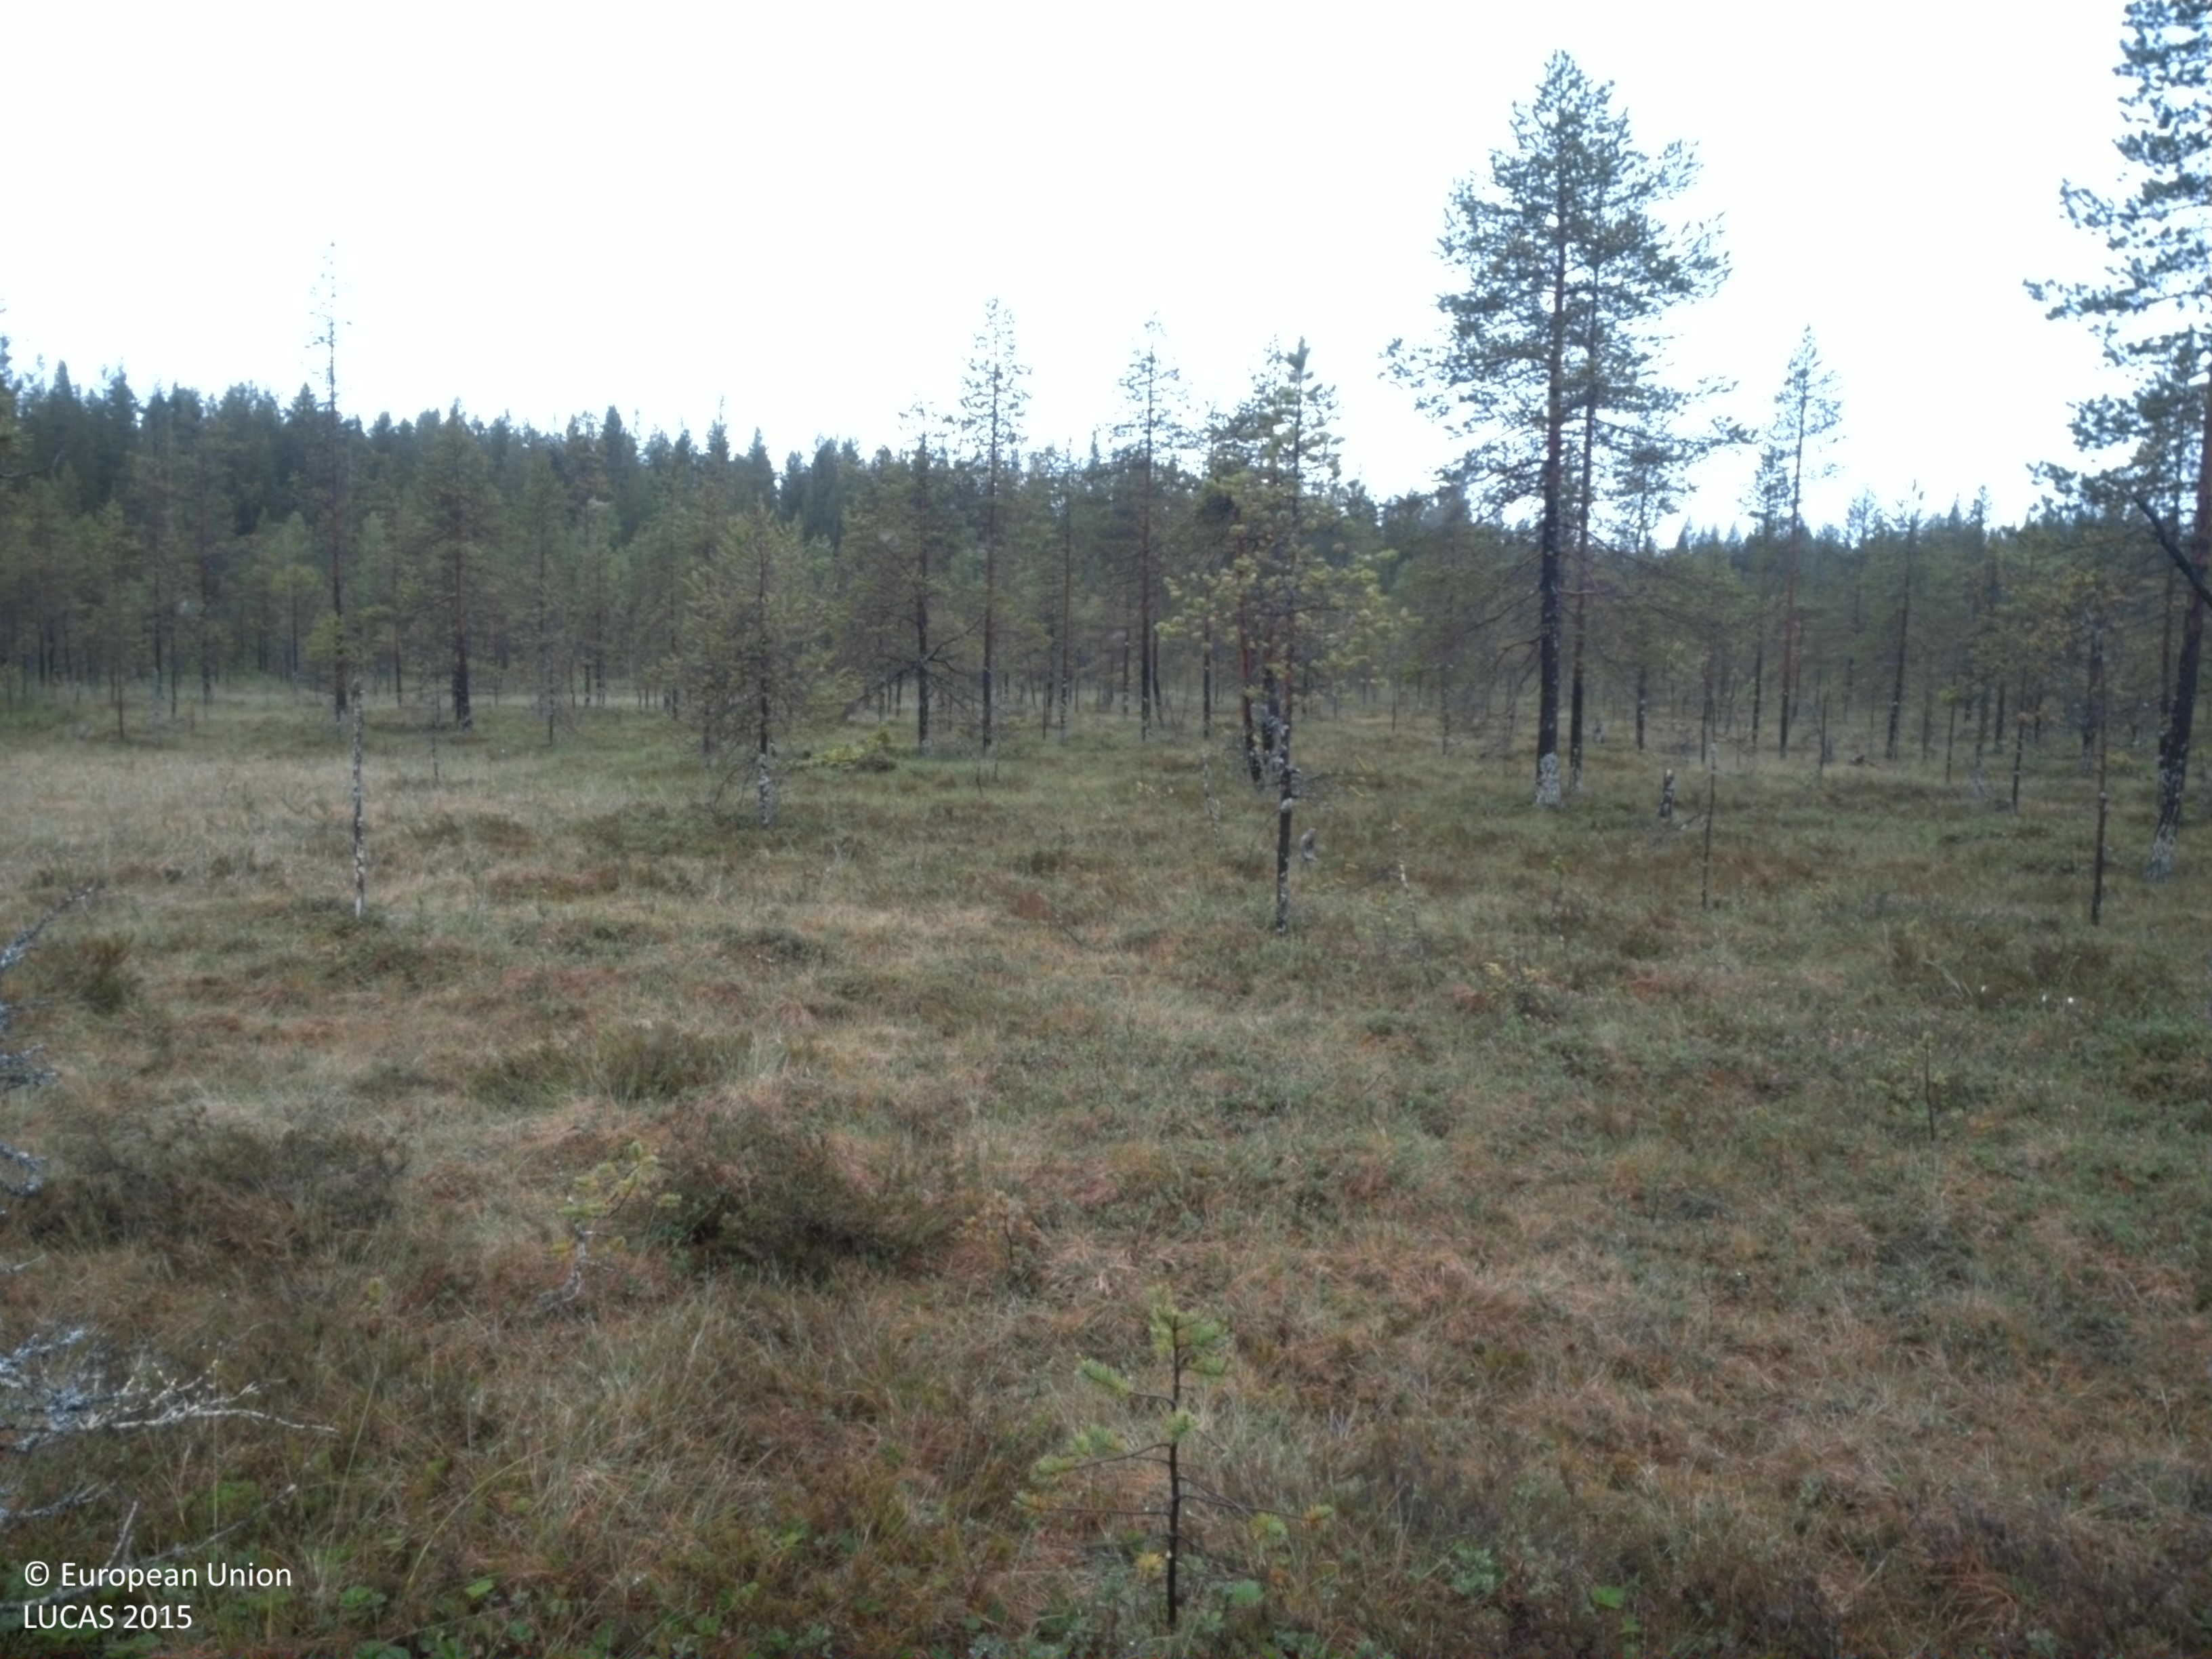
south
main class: Woodland
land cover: Pine dominated coniferous woodland
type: mire and swamp forests
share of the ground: 25 - 50 %
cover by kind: coniferous forest trees 40 %, herbaceous plants 30 %, shrubs 25 %, lichens and mosses 5 %
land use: Forestry
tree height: > 5 m
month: July
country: SE
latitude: 64.6050
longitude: 18.1801
